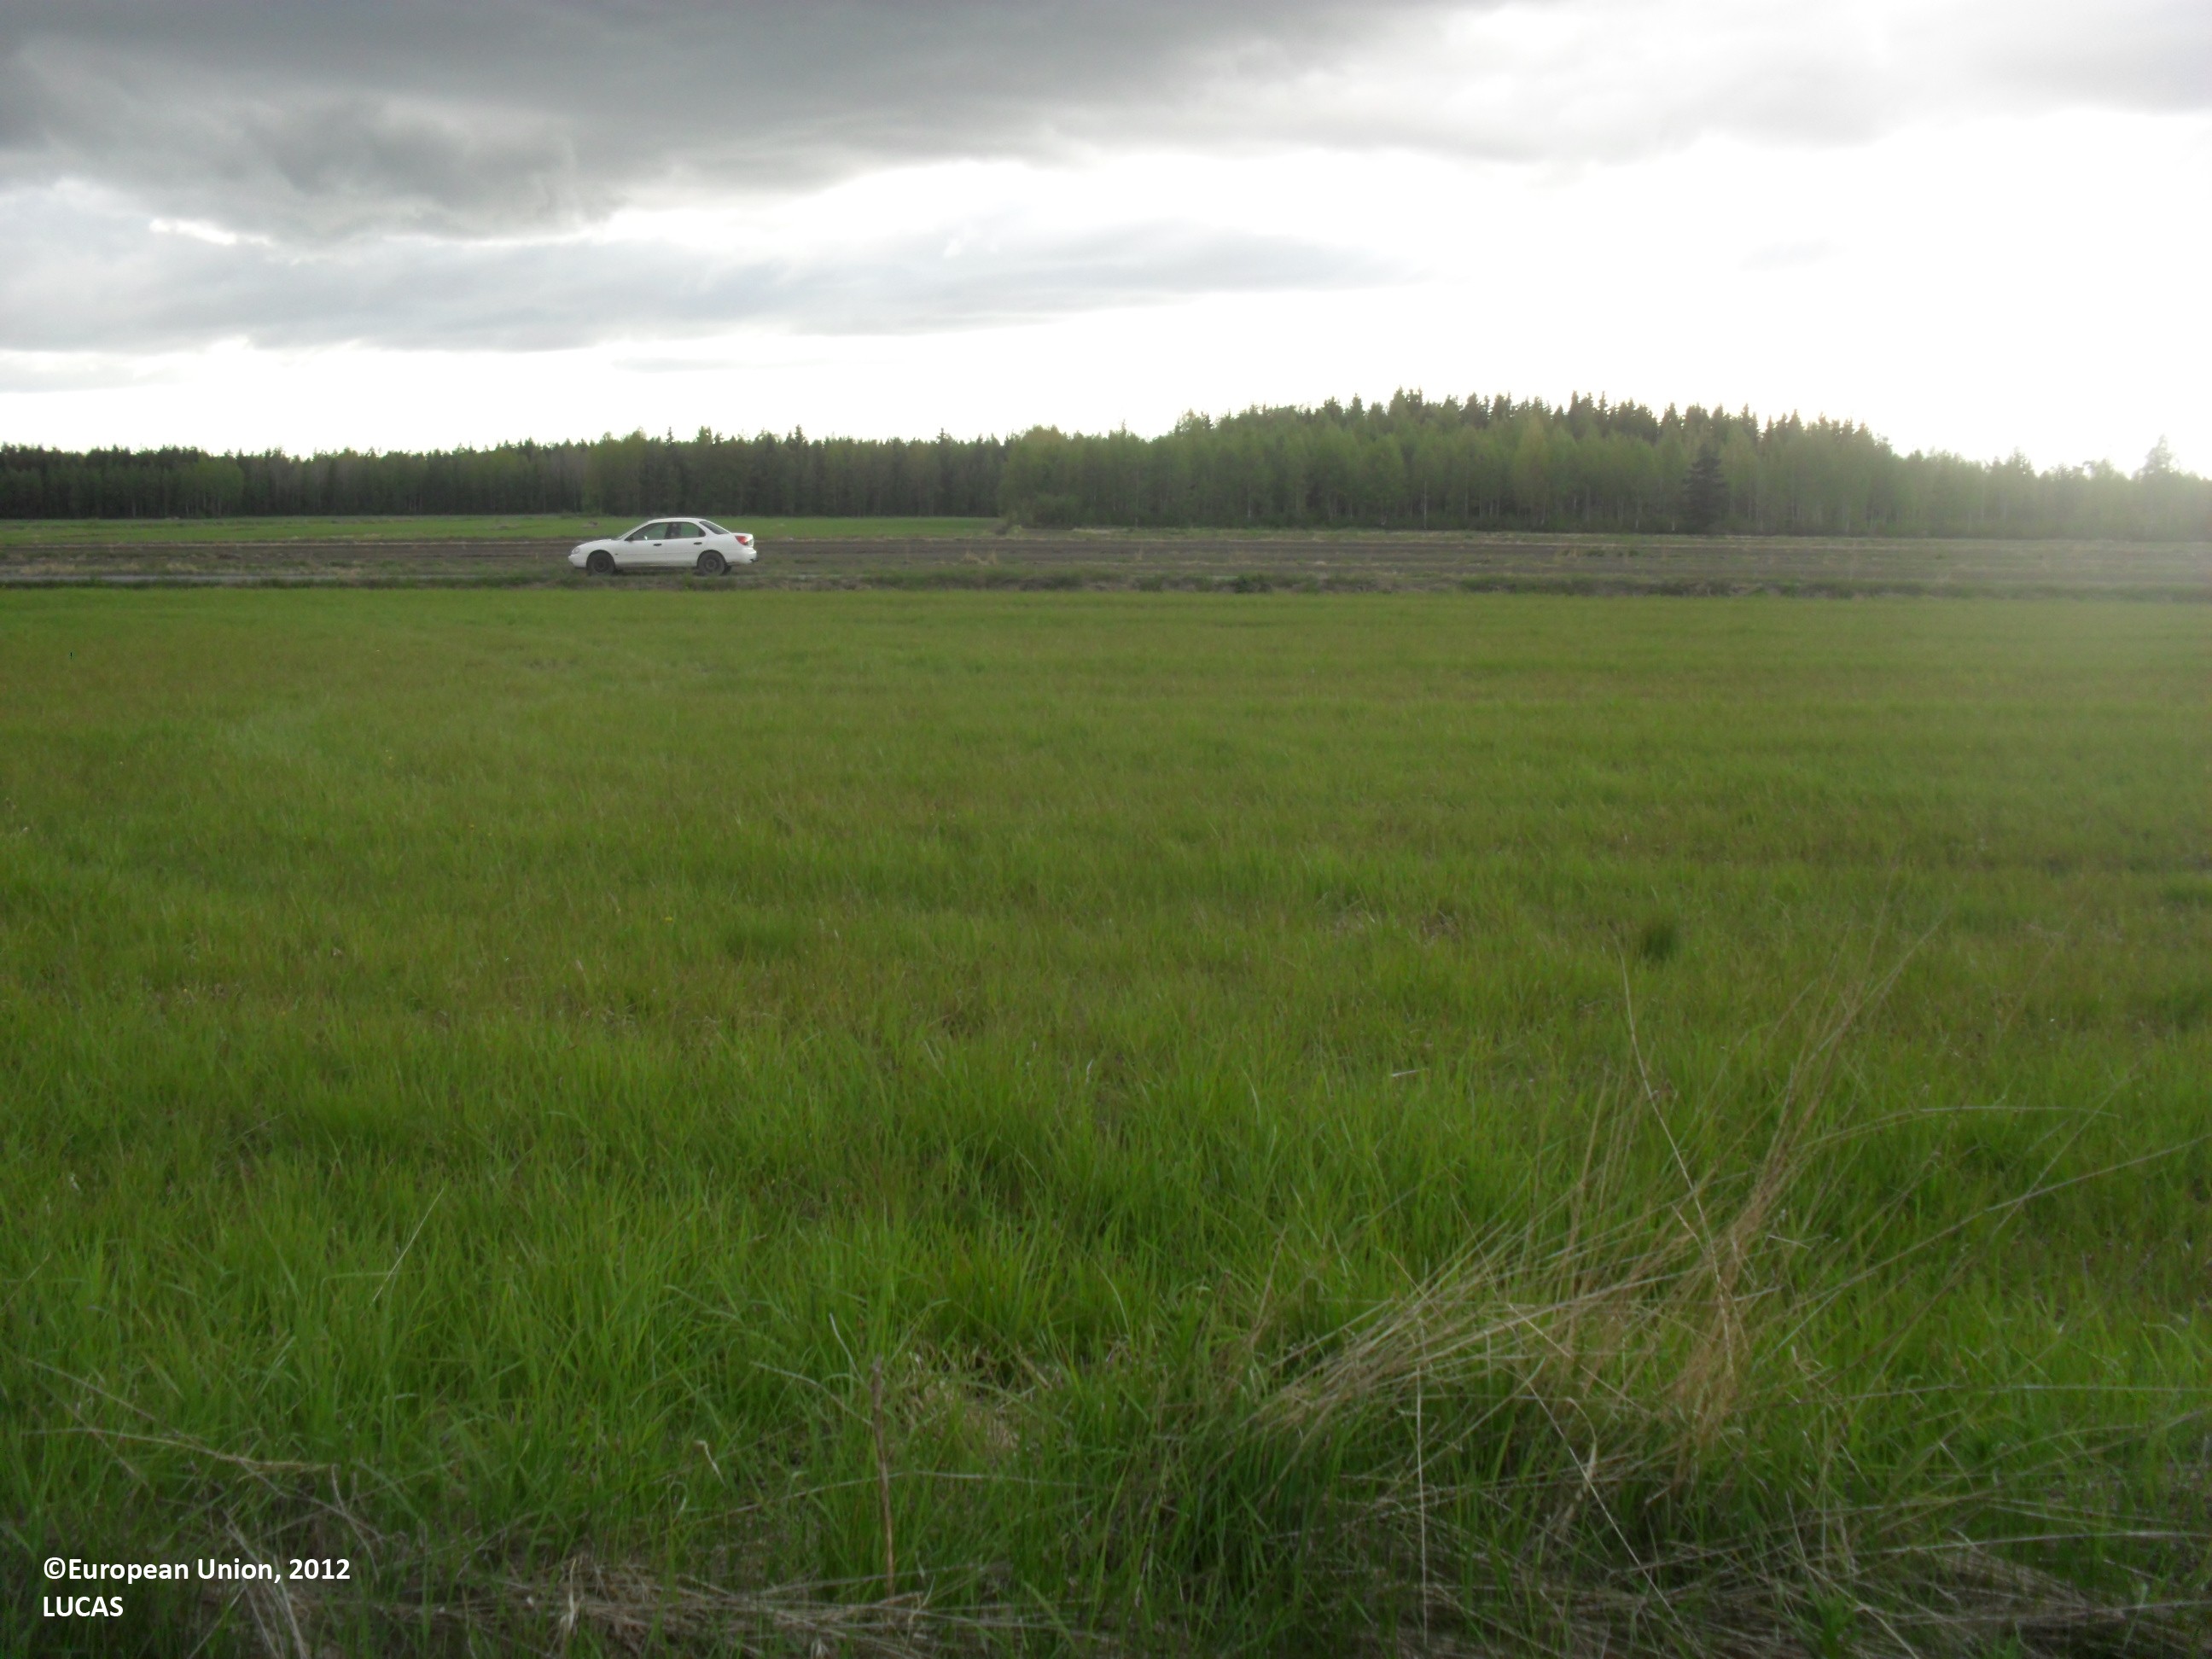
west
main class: Cropland
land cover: Temporary grasslands
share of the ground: > 75 %
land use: Agriculture (excluding fallow land and kitchen gardens)
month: June
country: FI
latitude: 62.9163
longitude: 23.3139
